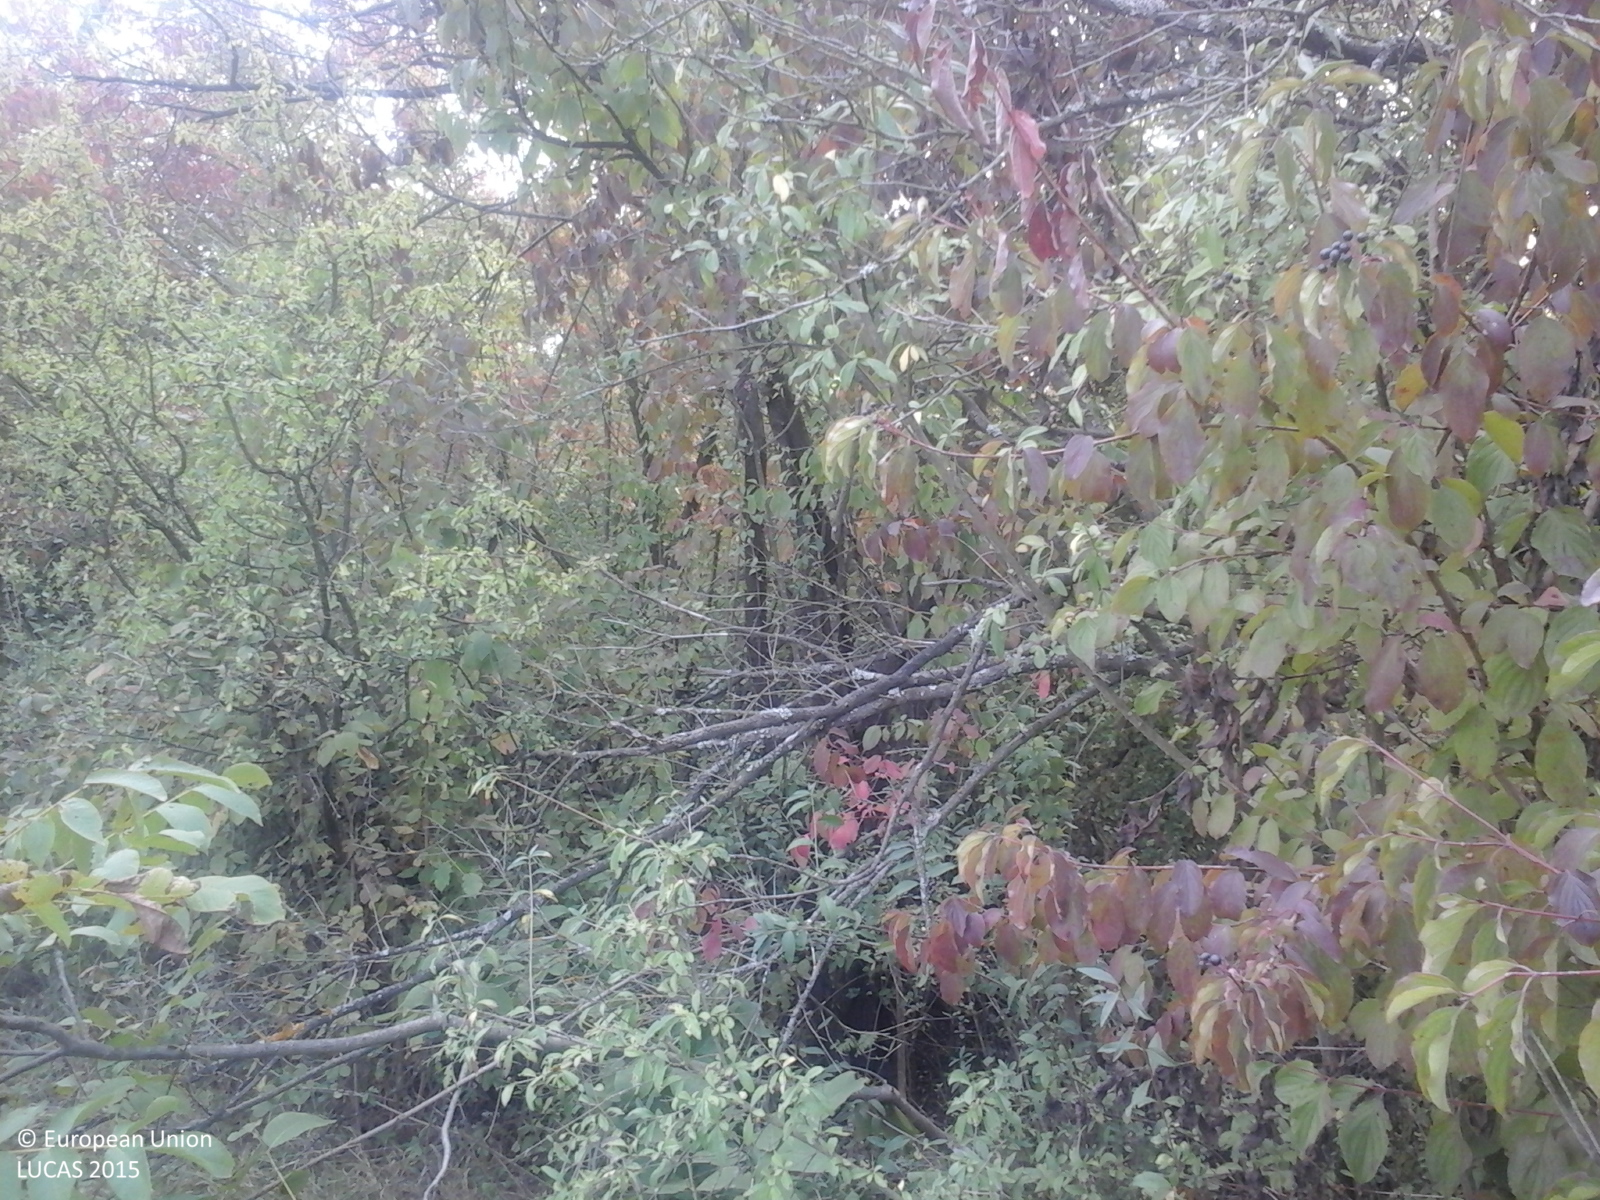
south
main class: Shrubland
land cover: Shrubland with sparse tree cover
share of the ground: > 75 %
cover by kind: shrubs 75 %, herbaceous plants 20 %, broadleaved forest trees 5 %
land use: Fallow land
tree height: > 5 m
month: September
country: RO
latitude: 45.8086
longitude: 22.8565
